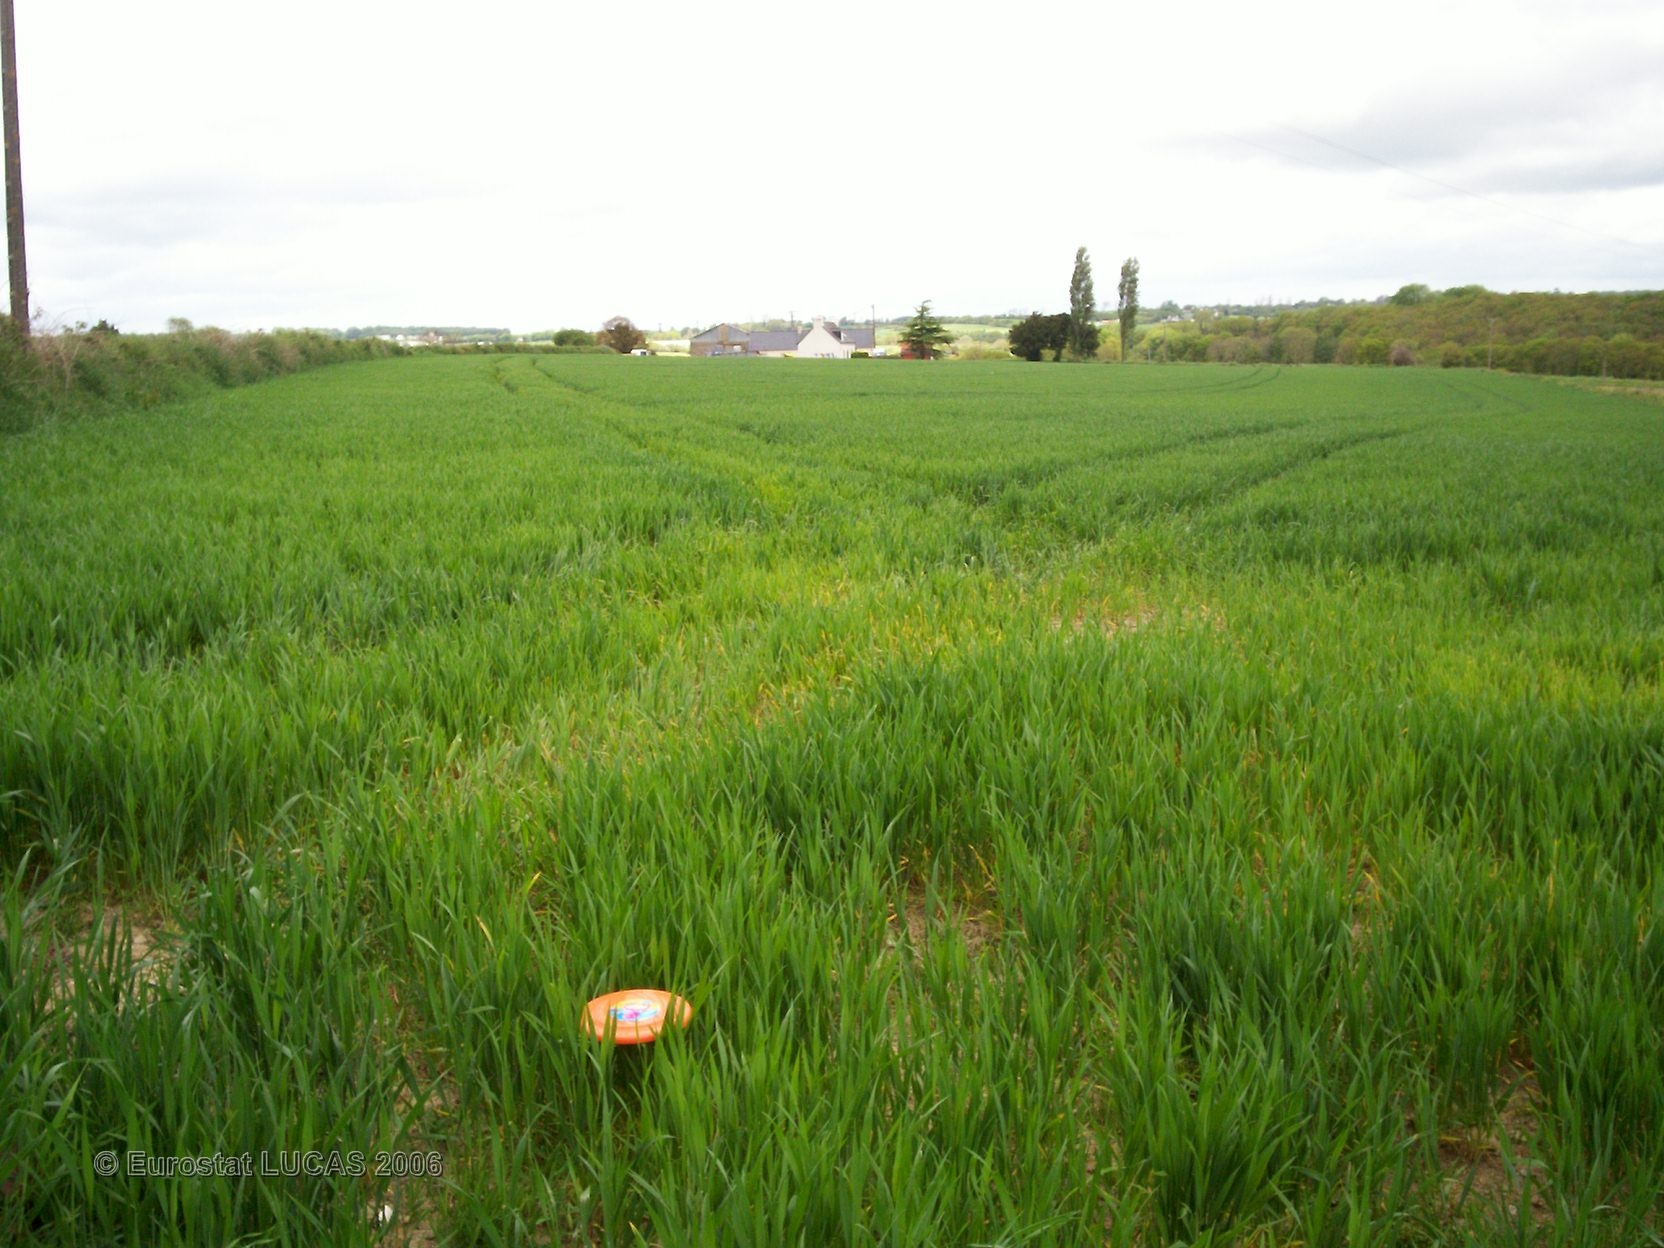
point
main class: Cropland
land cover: Common wheat
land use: Agriculture (excluding fallow land and kitchen gardens)
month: May
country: FR
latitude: 48.6102
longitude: -3.7974
